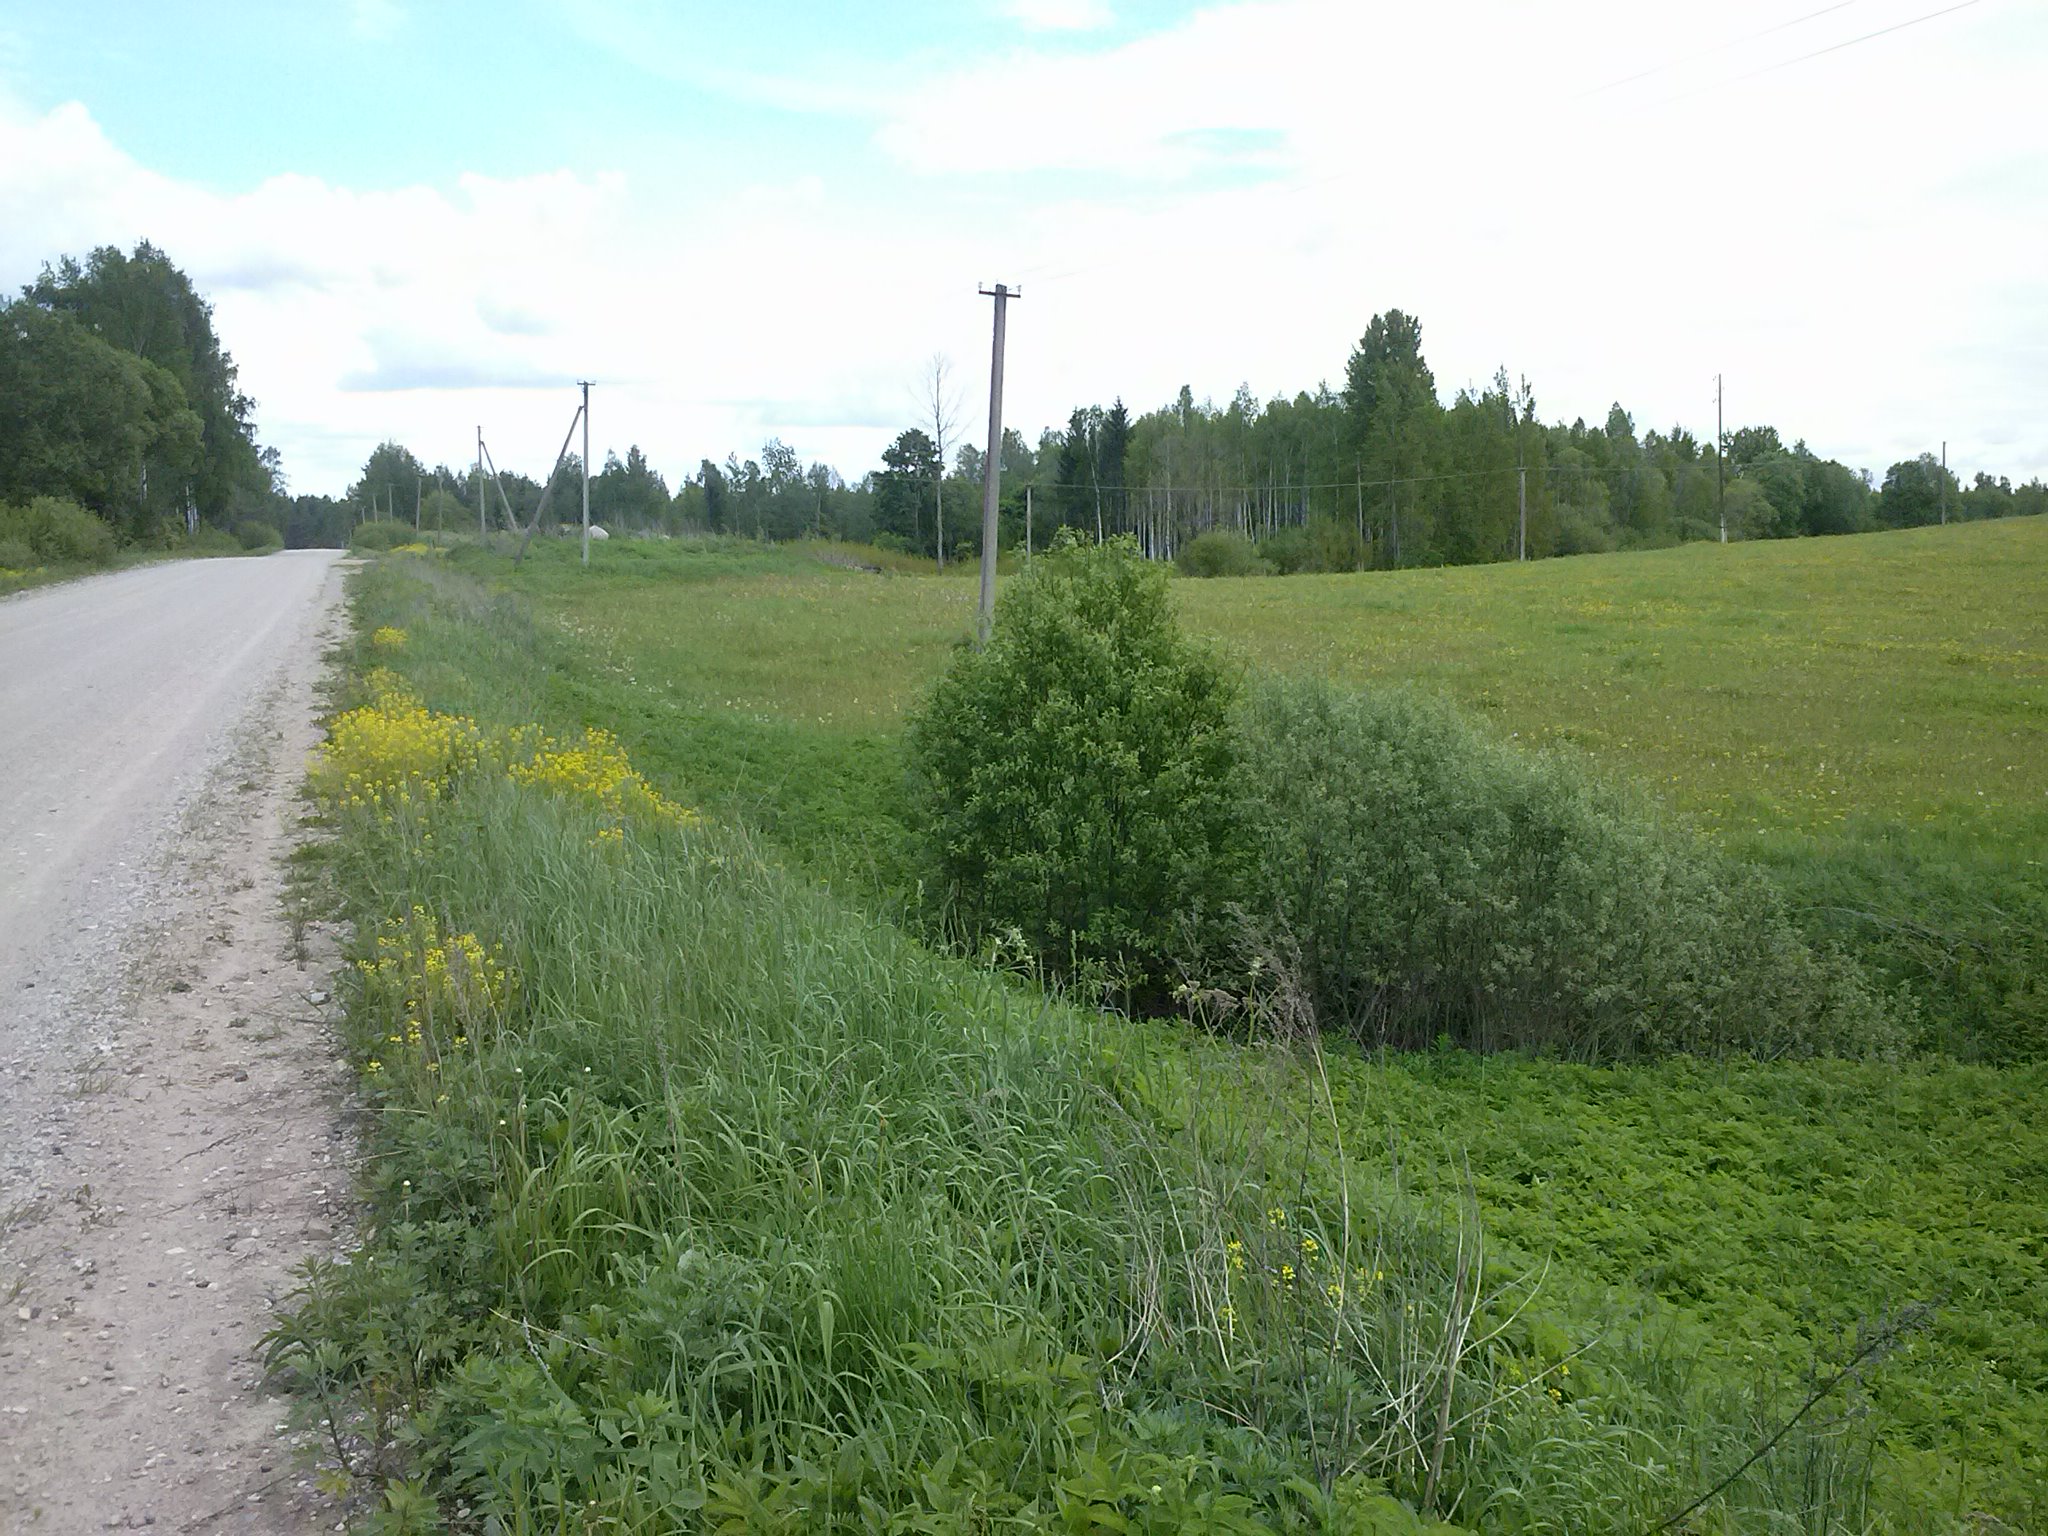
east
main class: Grassland
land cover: Grassland without tree/shrub cover
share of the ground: > 75 %
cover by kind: herbaceous plants 100 %
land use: Agriculture (excluding fallow land and kitchen gardens)
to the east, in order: Grassland without tree/shrub cover; Electric lines; Grassland without tree/shrub cover; Tracks; Grassland without tree/shrub cover; Broadleaved woodland
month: May
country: LV
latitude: 56.2617
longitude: 27.7705
